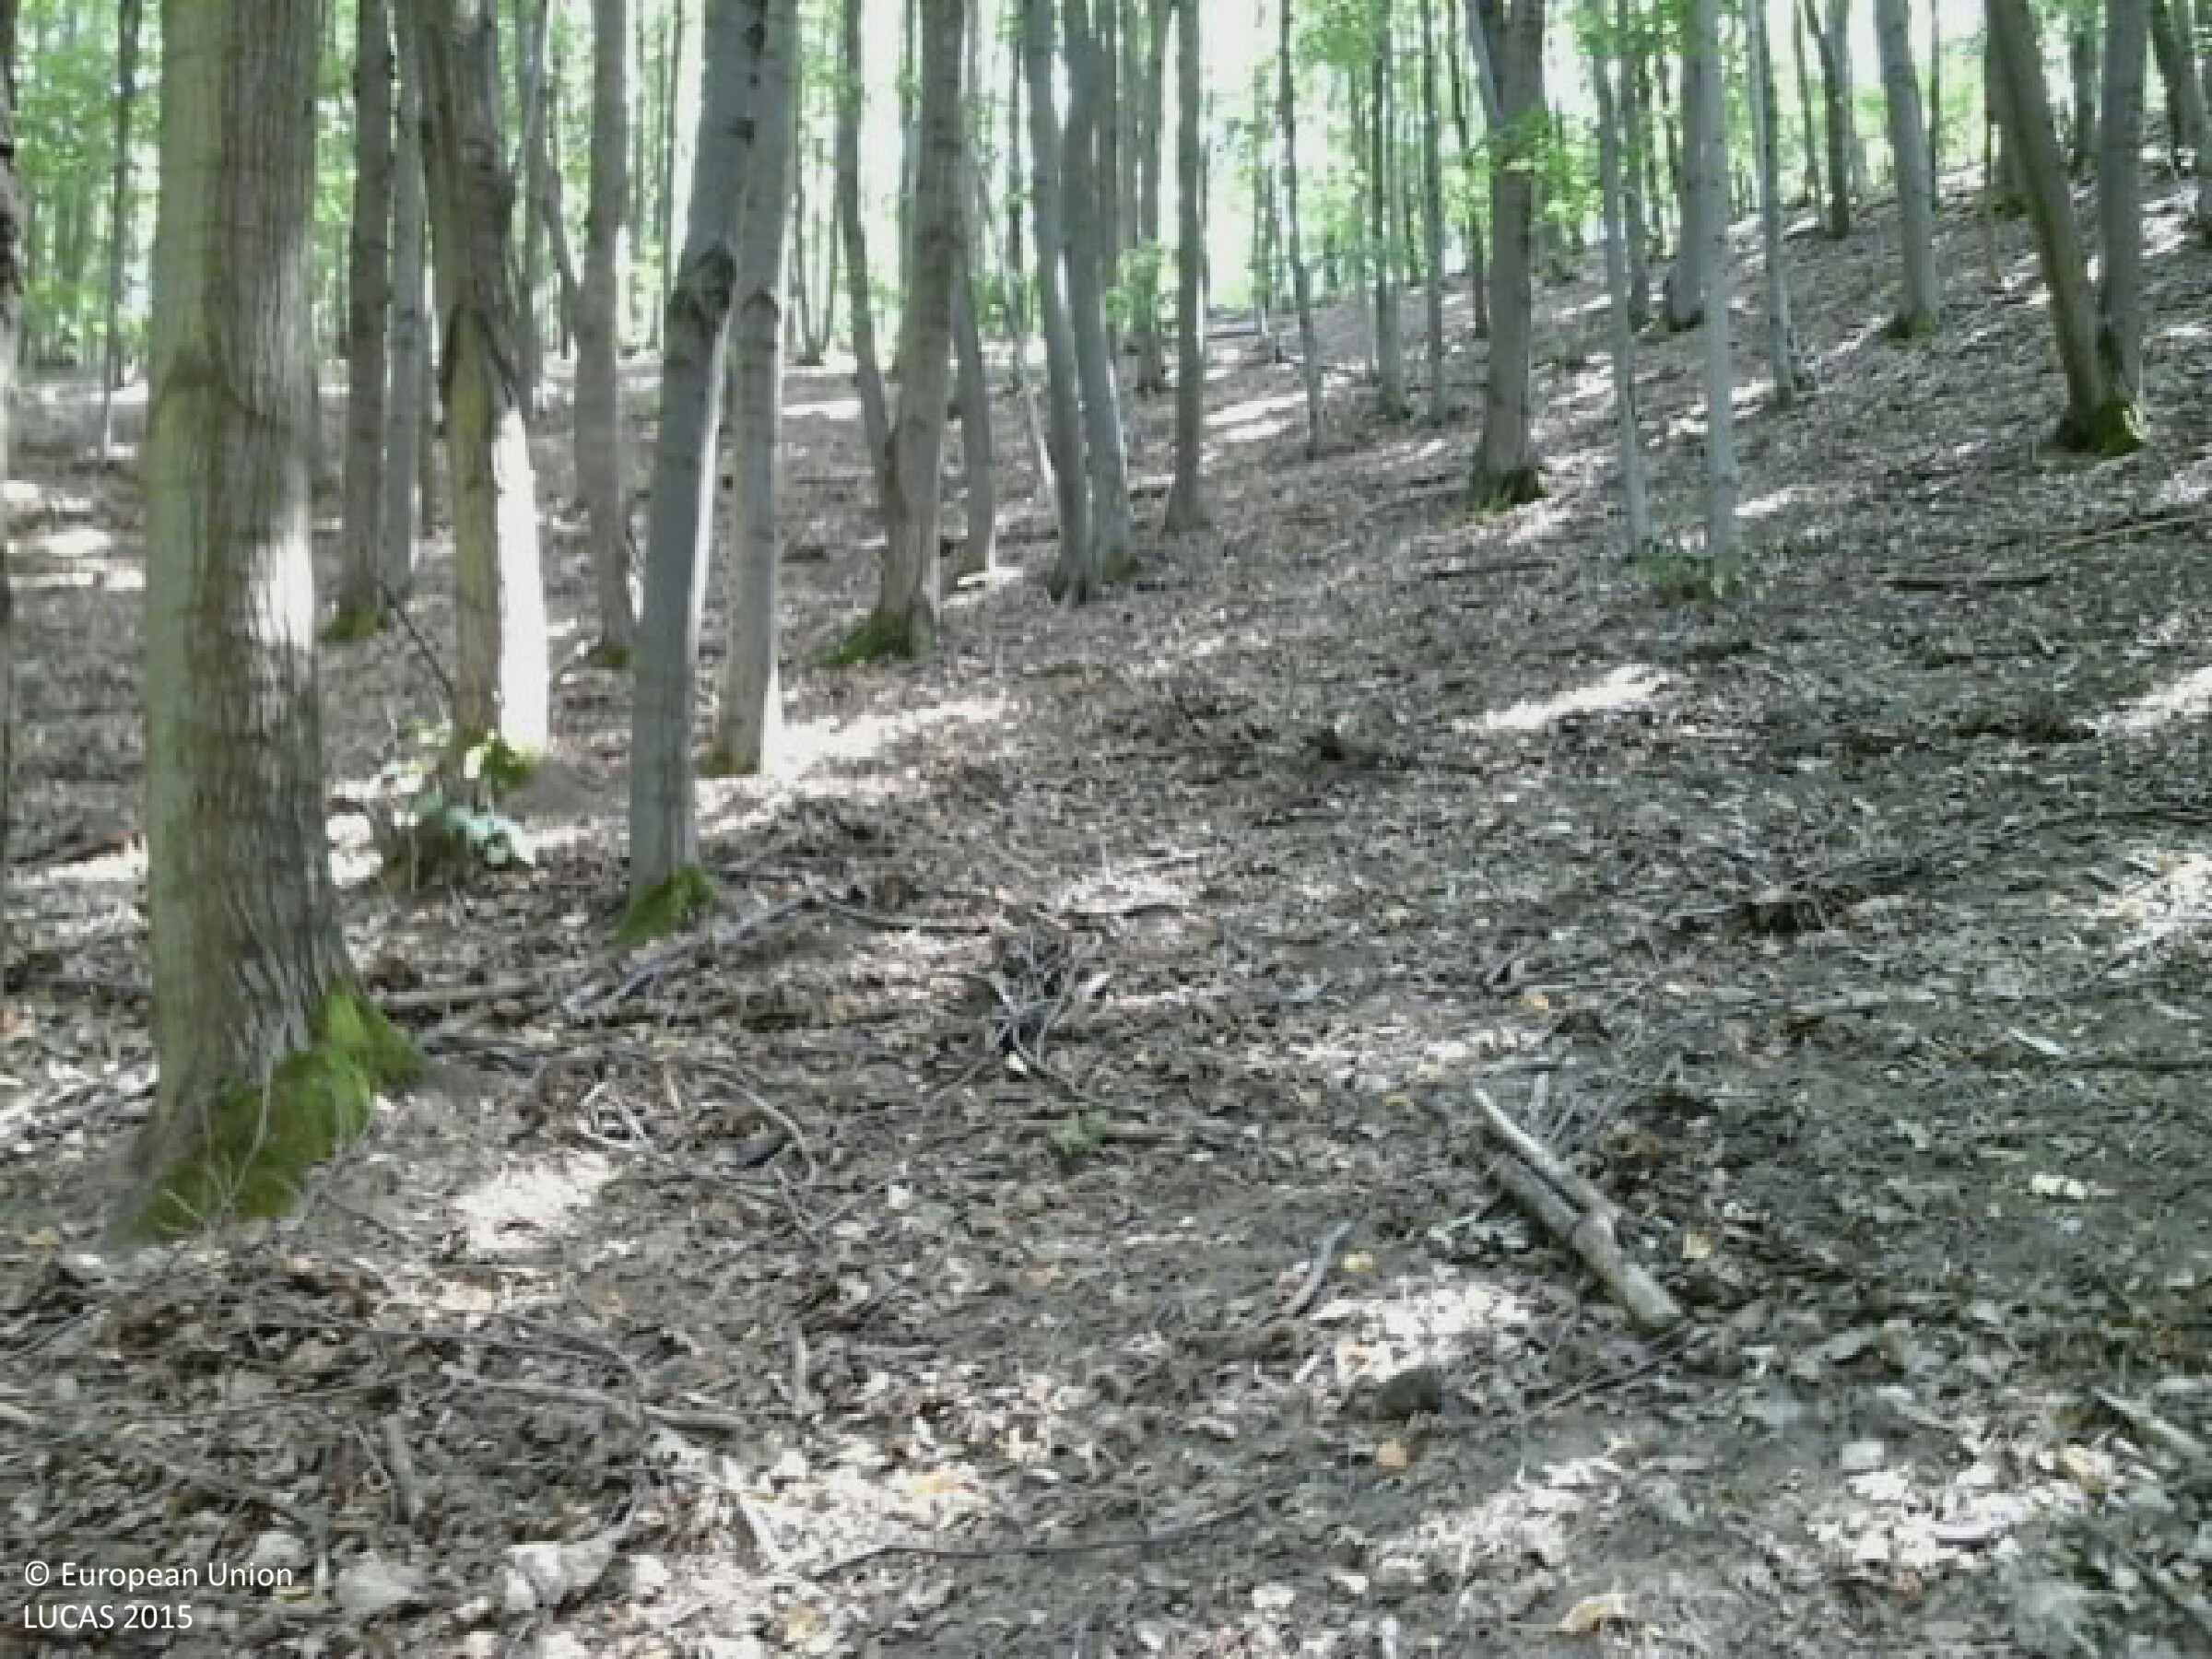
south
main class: Woodland
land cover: Broadleaved woodland
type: beech forest
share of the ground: 50 - 75 %
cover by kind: broadleaved forest trees 100 %
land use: Forestry
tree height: > 5 m
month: July
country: HU
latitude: 47.7958
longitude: 19.2723
